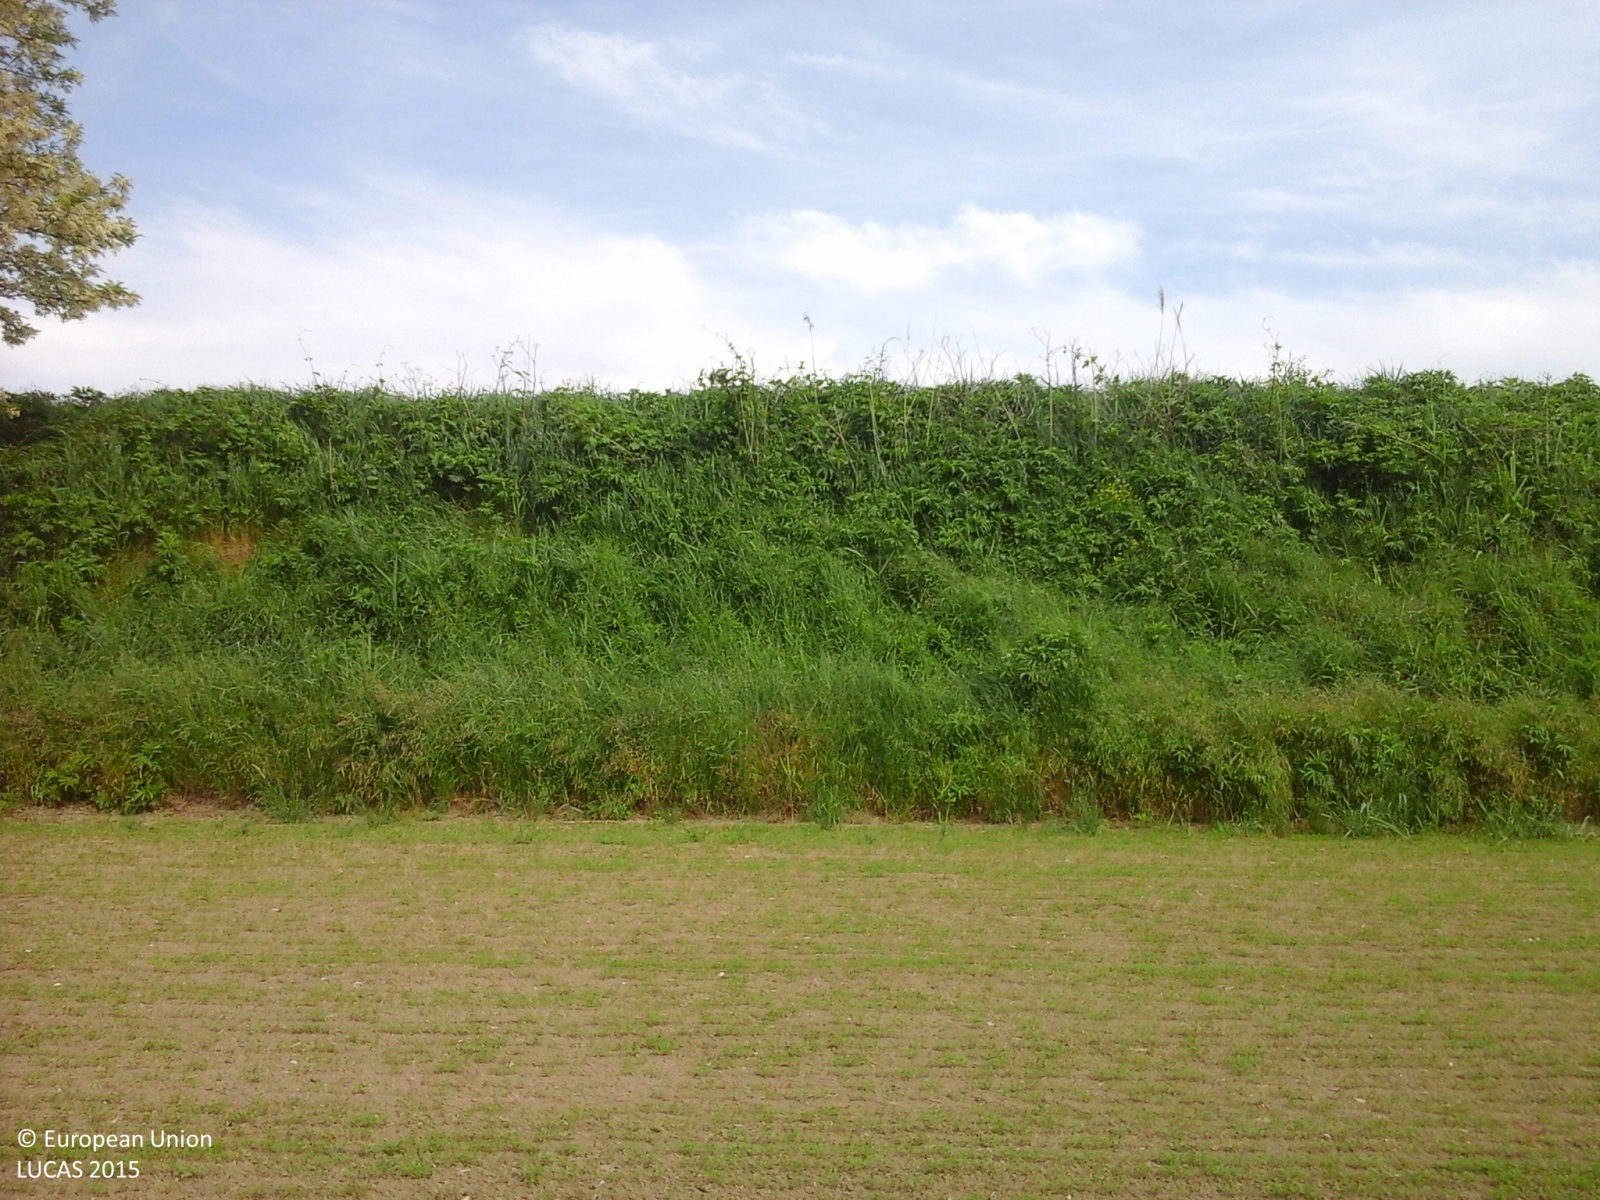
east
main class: Cropland
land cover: Lucerne
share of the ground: < 10 %
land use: Agriculture (excluding fallow land and kitchen gardens)
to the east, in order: Lucerne; Grassland with sparse tree/shrub cover; Grass margins; Inland fresh running water; Grass margins; Tracks; Managed hedges; Durum wheat; Abandoned hedges; Ditches and canals; Durum wheat
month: May
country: IT
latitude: 45.0686
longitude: 9.1760
